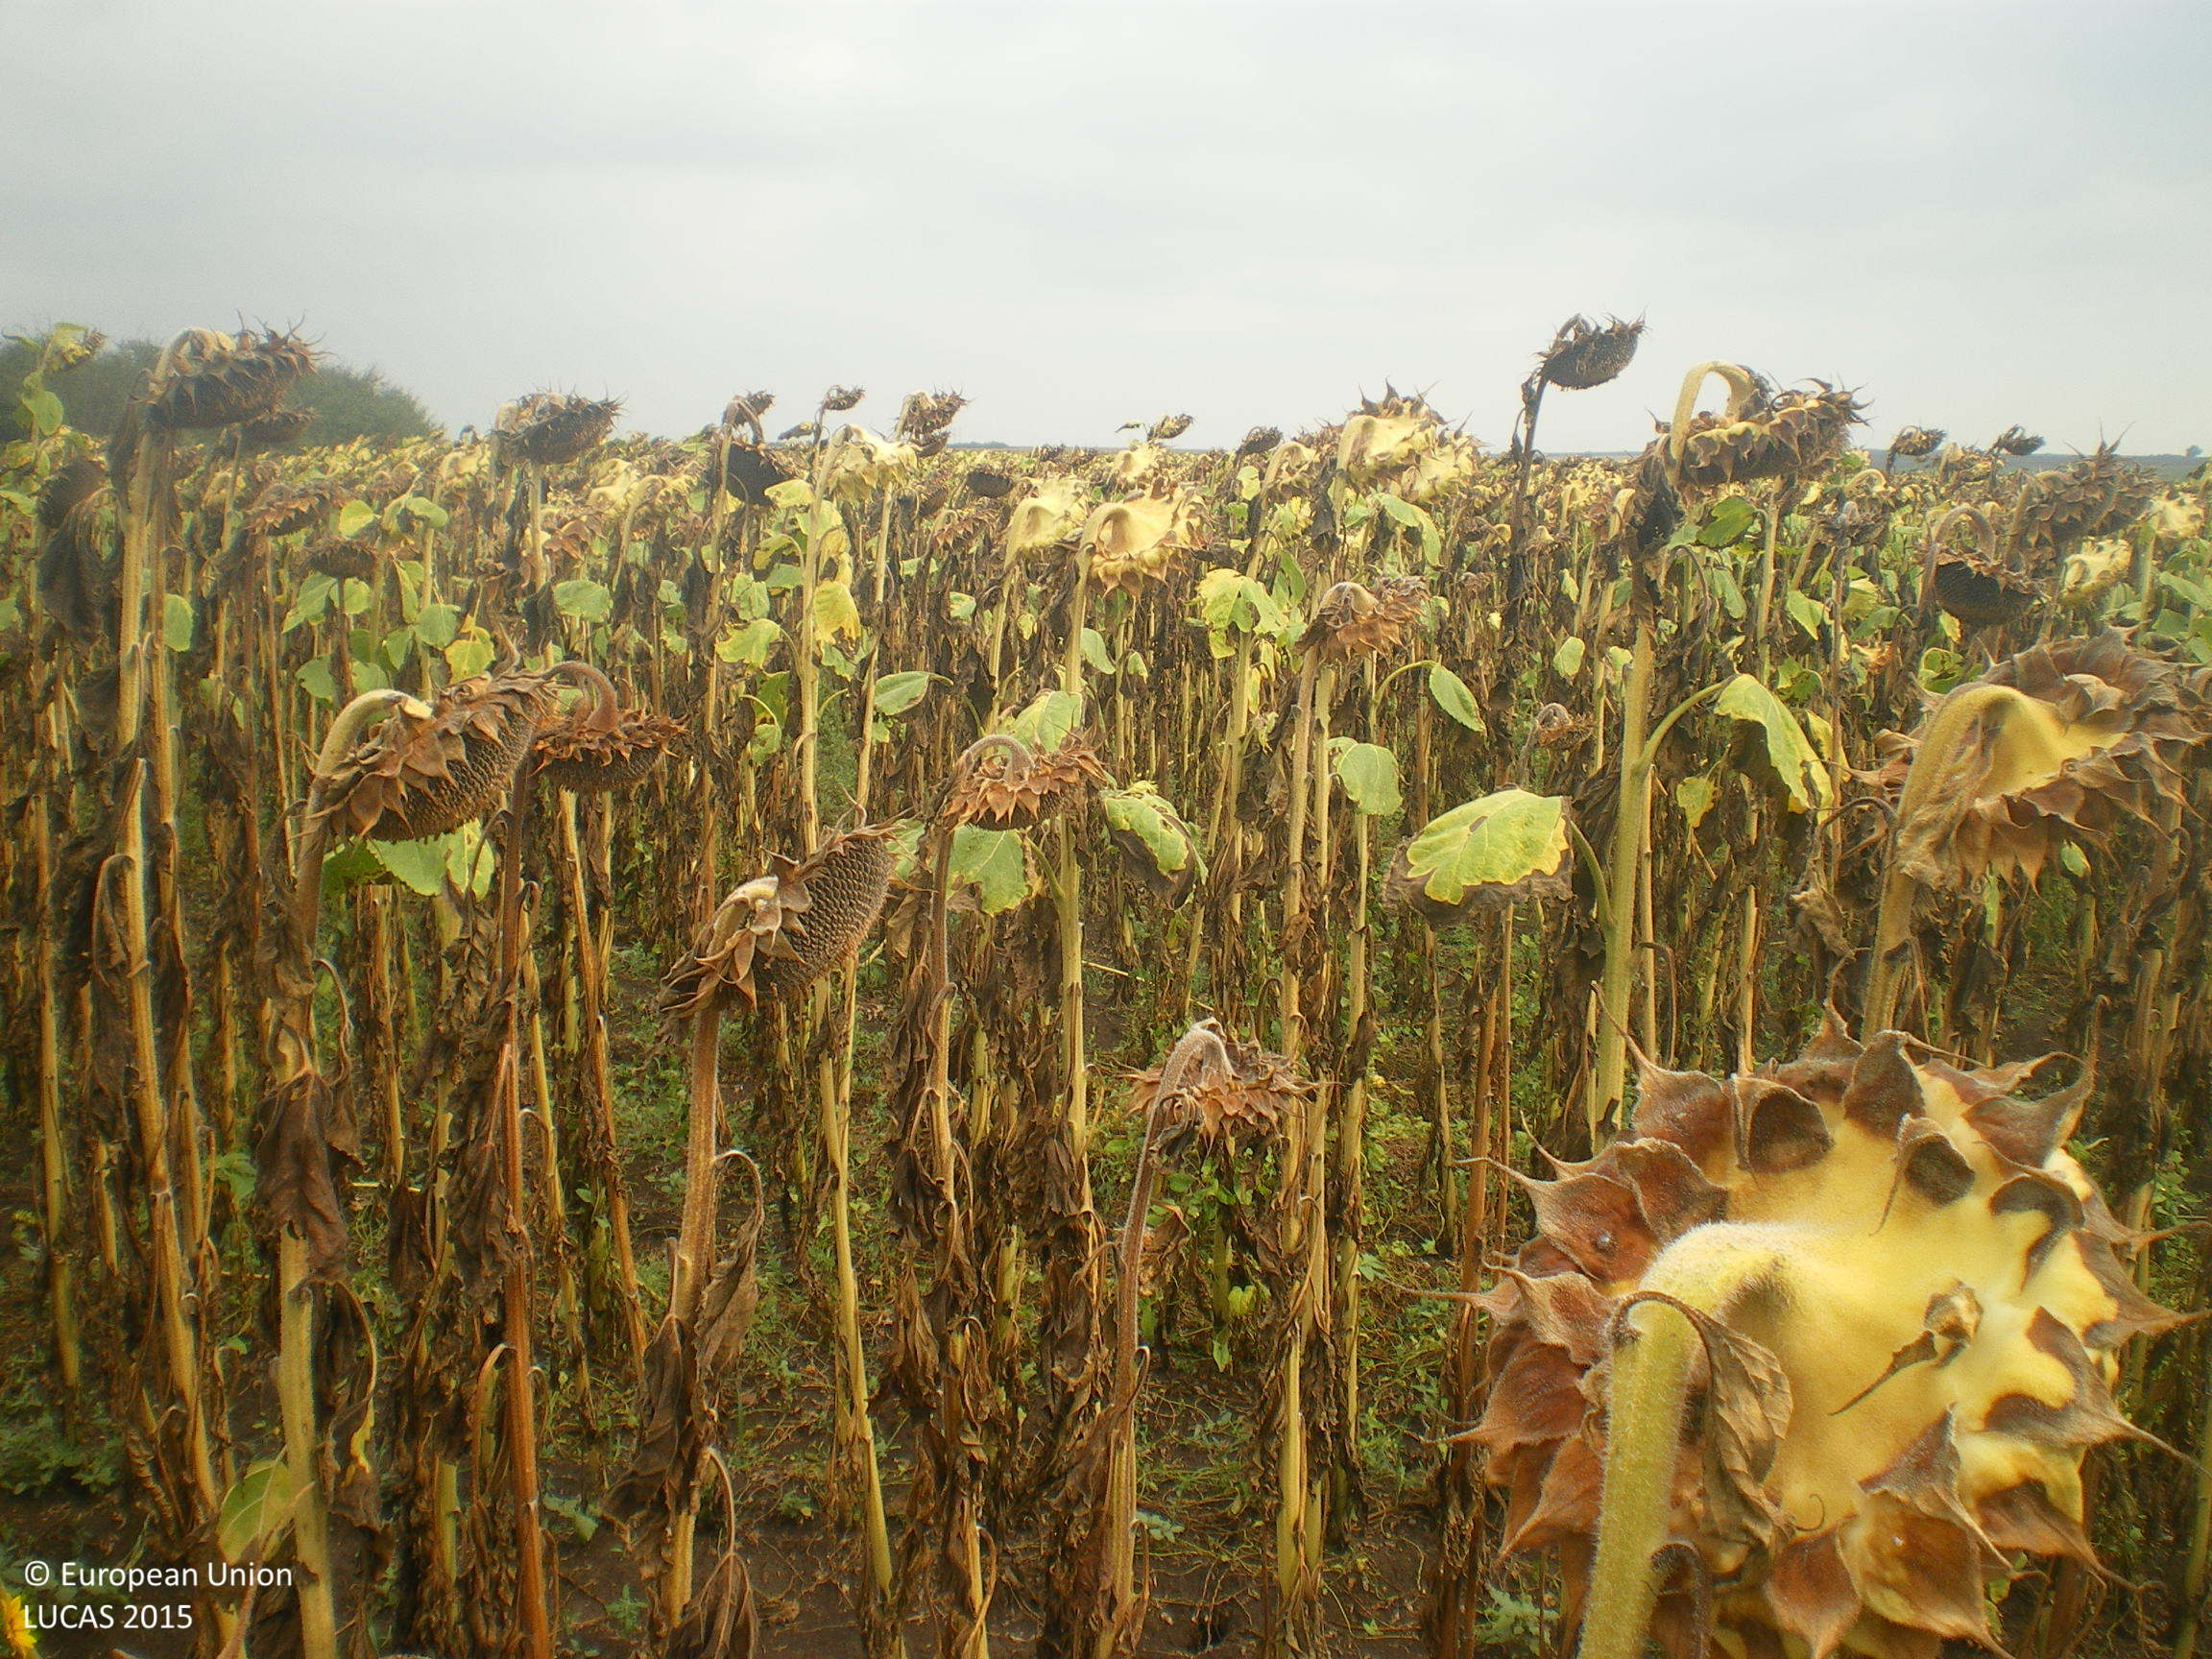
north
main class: Cropland
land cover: Sunflower
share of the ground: > 75 %
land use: Agriculture (excluding fallow land and kitchen gardens)
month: August
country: BG
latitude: 42.3236
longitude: 25.9122
